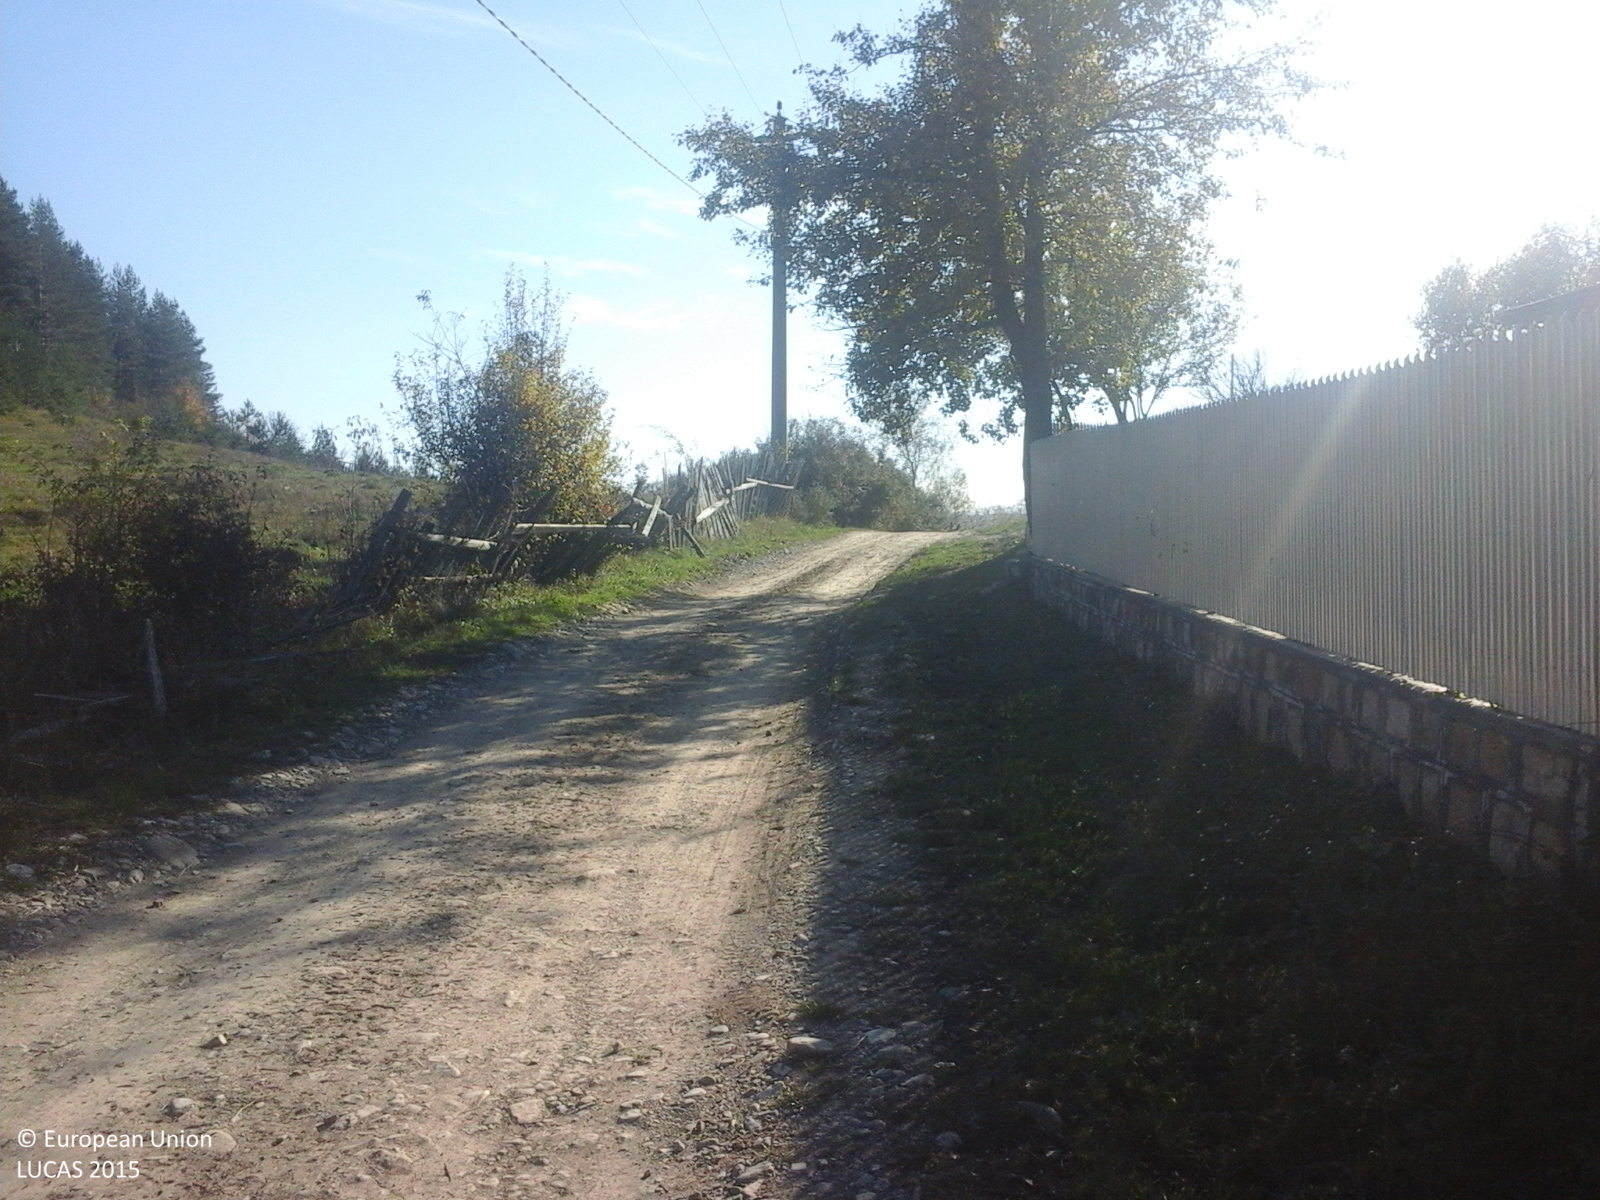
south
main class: Grassland
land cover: Grassland without tree/shrub cover
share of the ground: > 75 %
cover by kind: herbaceous plants 100 %
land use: Residential
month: October
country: RO
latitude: 45.9301
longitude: 26.6800
